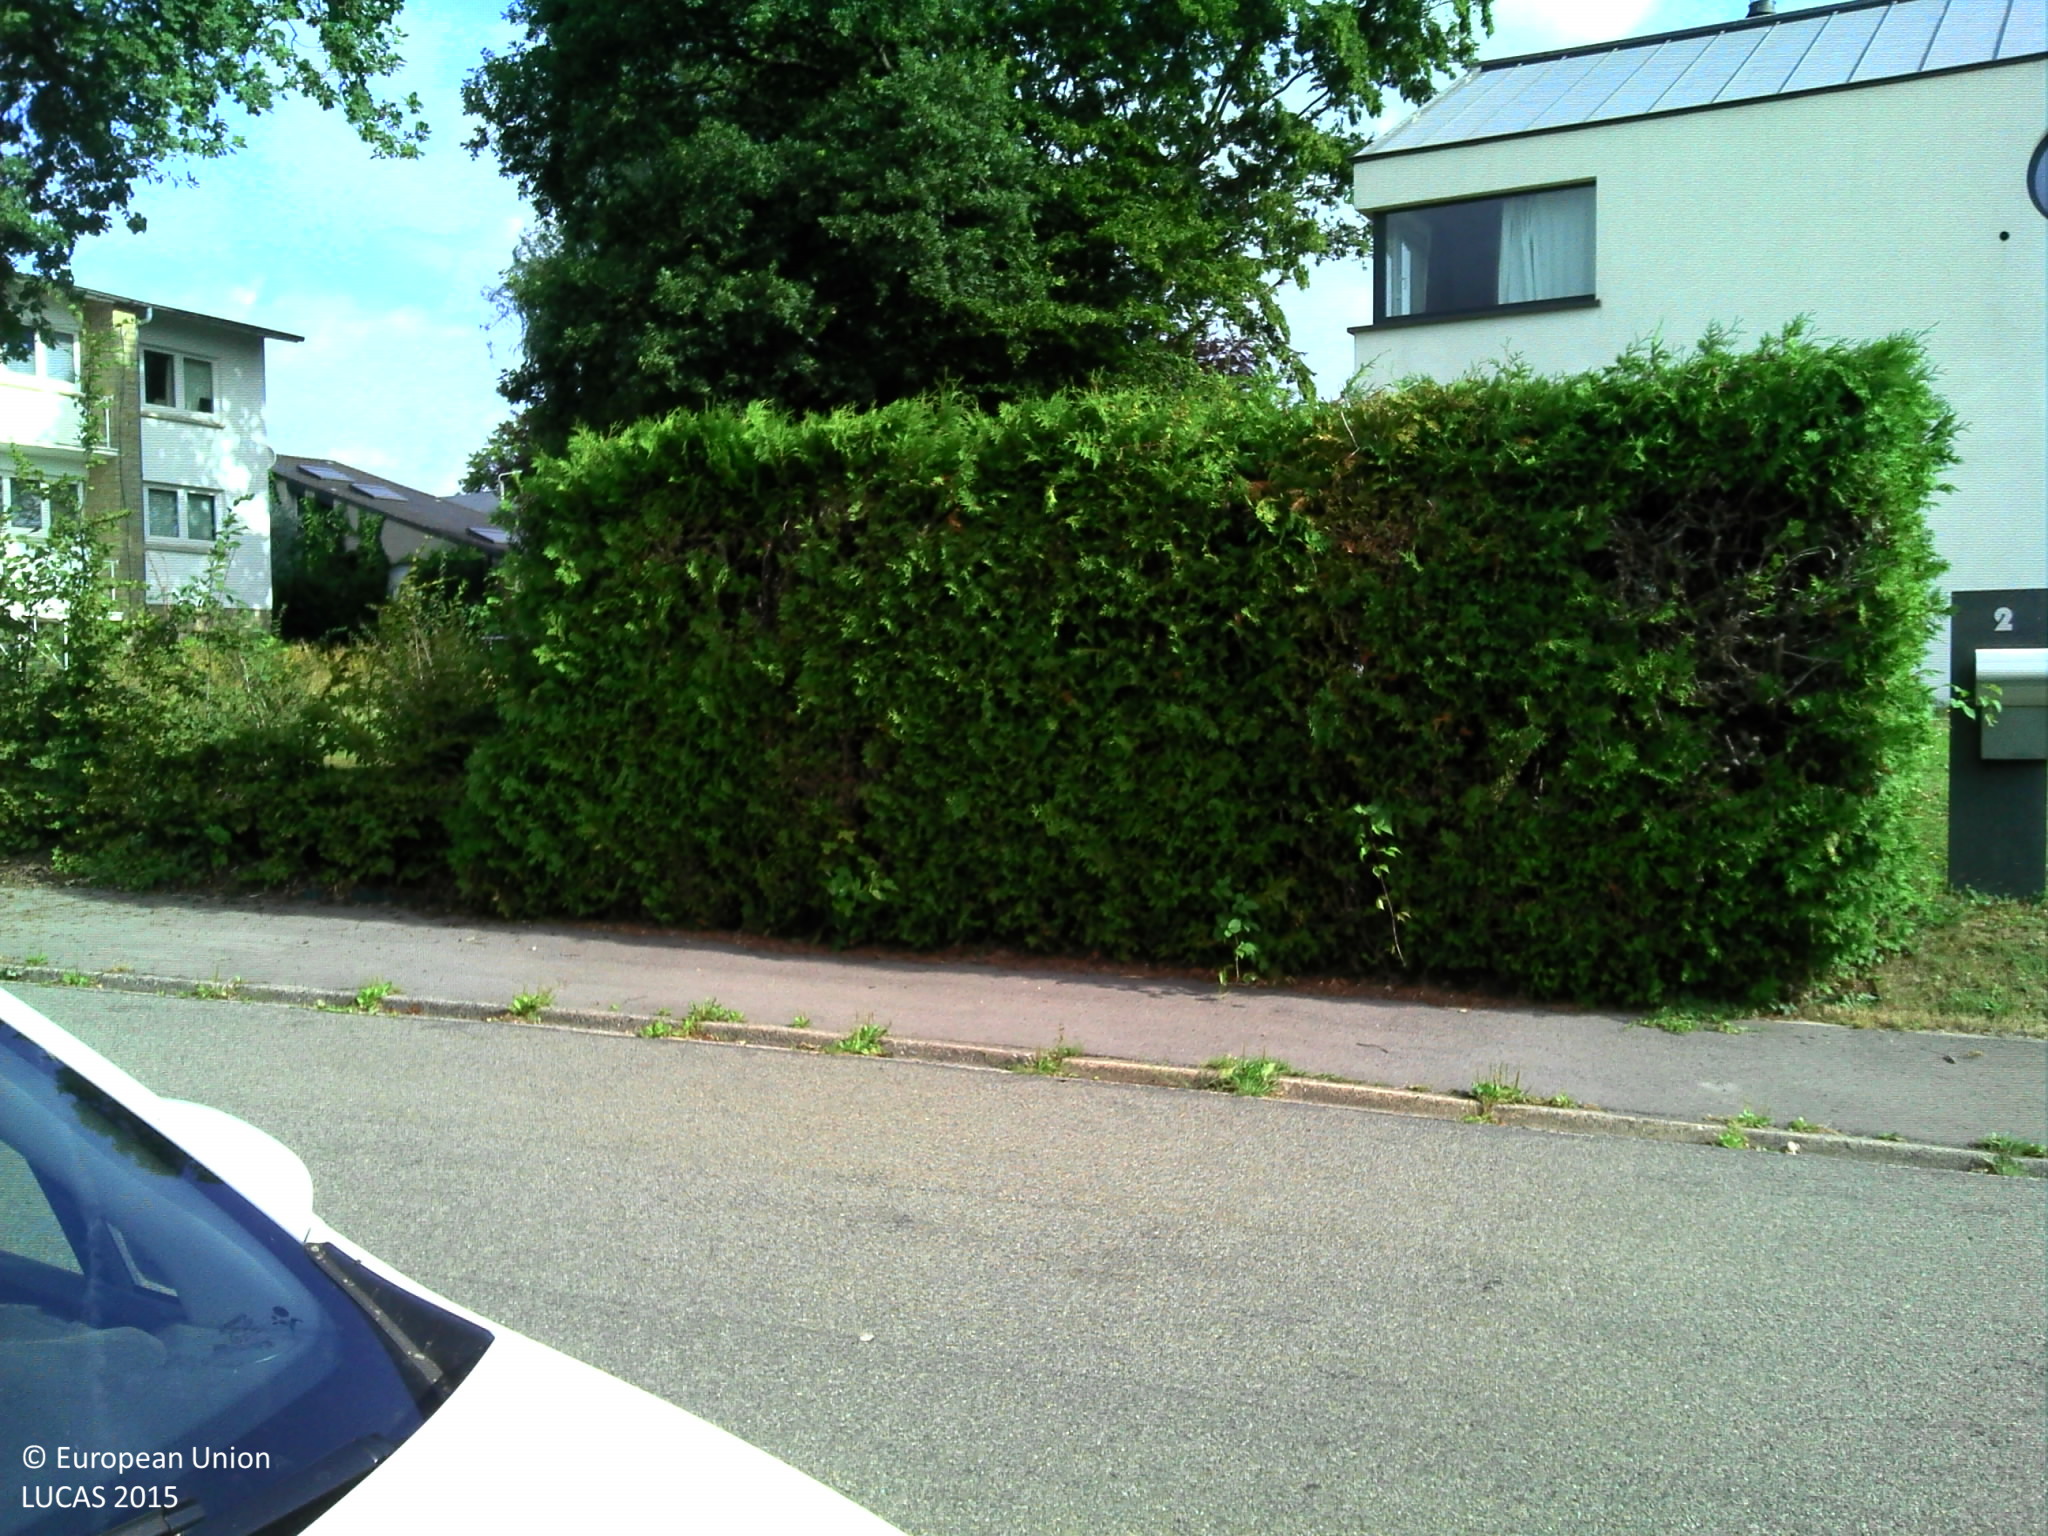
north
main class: Grassland
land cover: Grassland without tree/shrub cover
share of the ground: > 75 %
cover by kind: herbaceous plants 100 %
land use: Residential
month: July
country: BE
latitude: 49.6758
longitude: 5.8278
